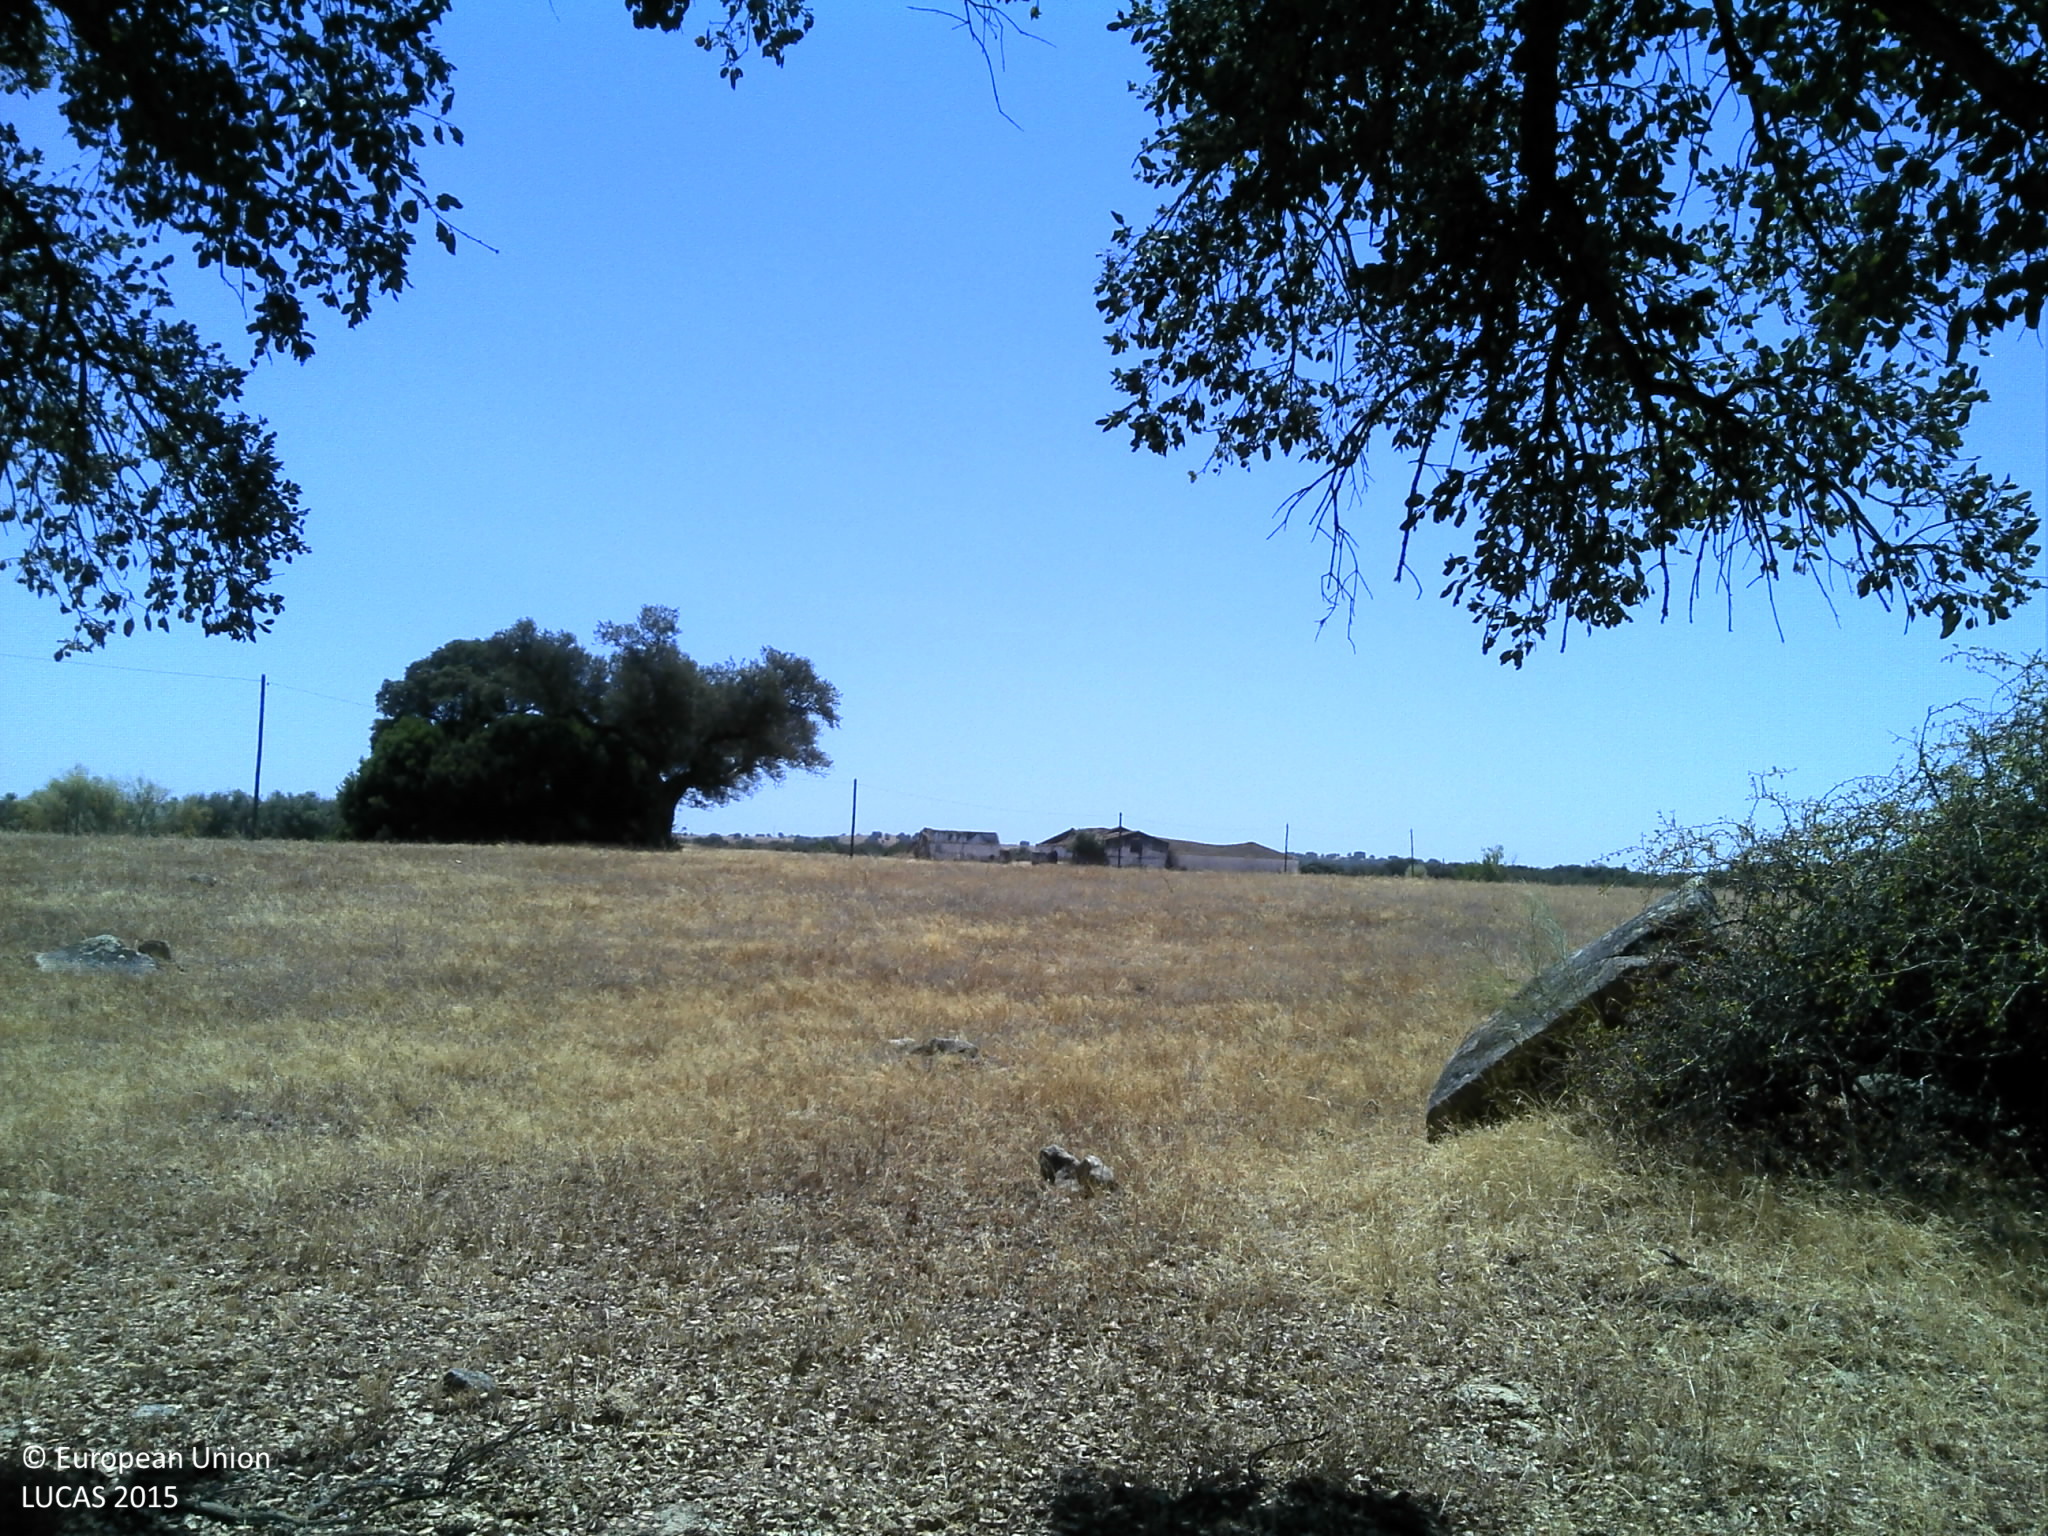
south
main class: Woodland
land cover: Broadleaved woodland
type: broadleaved evergreen forest
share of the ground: 25 - 50 %
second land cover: Grassland without tree/shrub cover
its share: 25 - 50 %
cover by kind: unconsolidated bare surface 45 %, herbaceous plants 30 %, broadleaved forest trees 25 %
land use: Forestry
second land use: Agriculture (excluding fallow land and kitchen gardens)
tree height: > 5 m
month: July
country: PT
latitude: 38.4095
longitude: -7.4676
